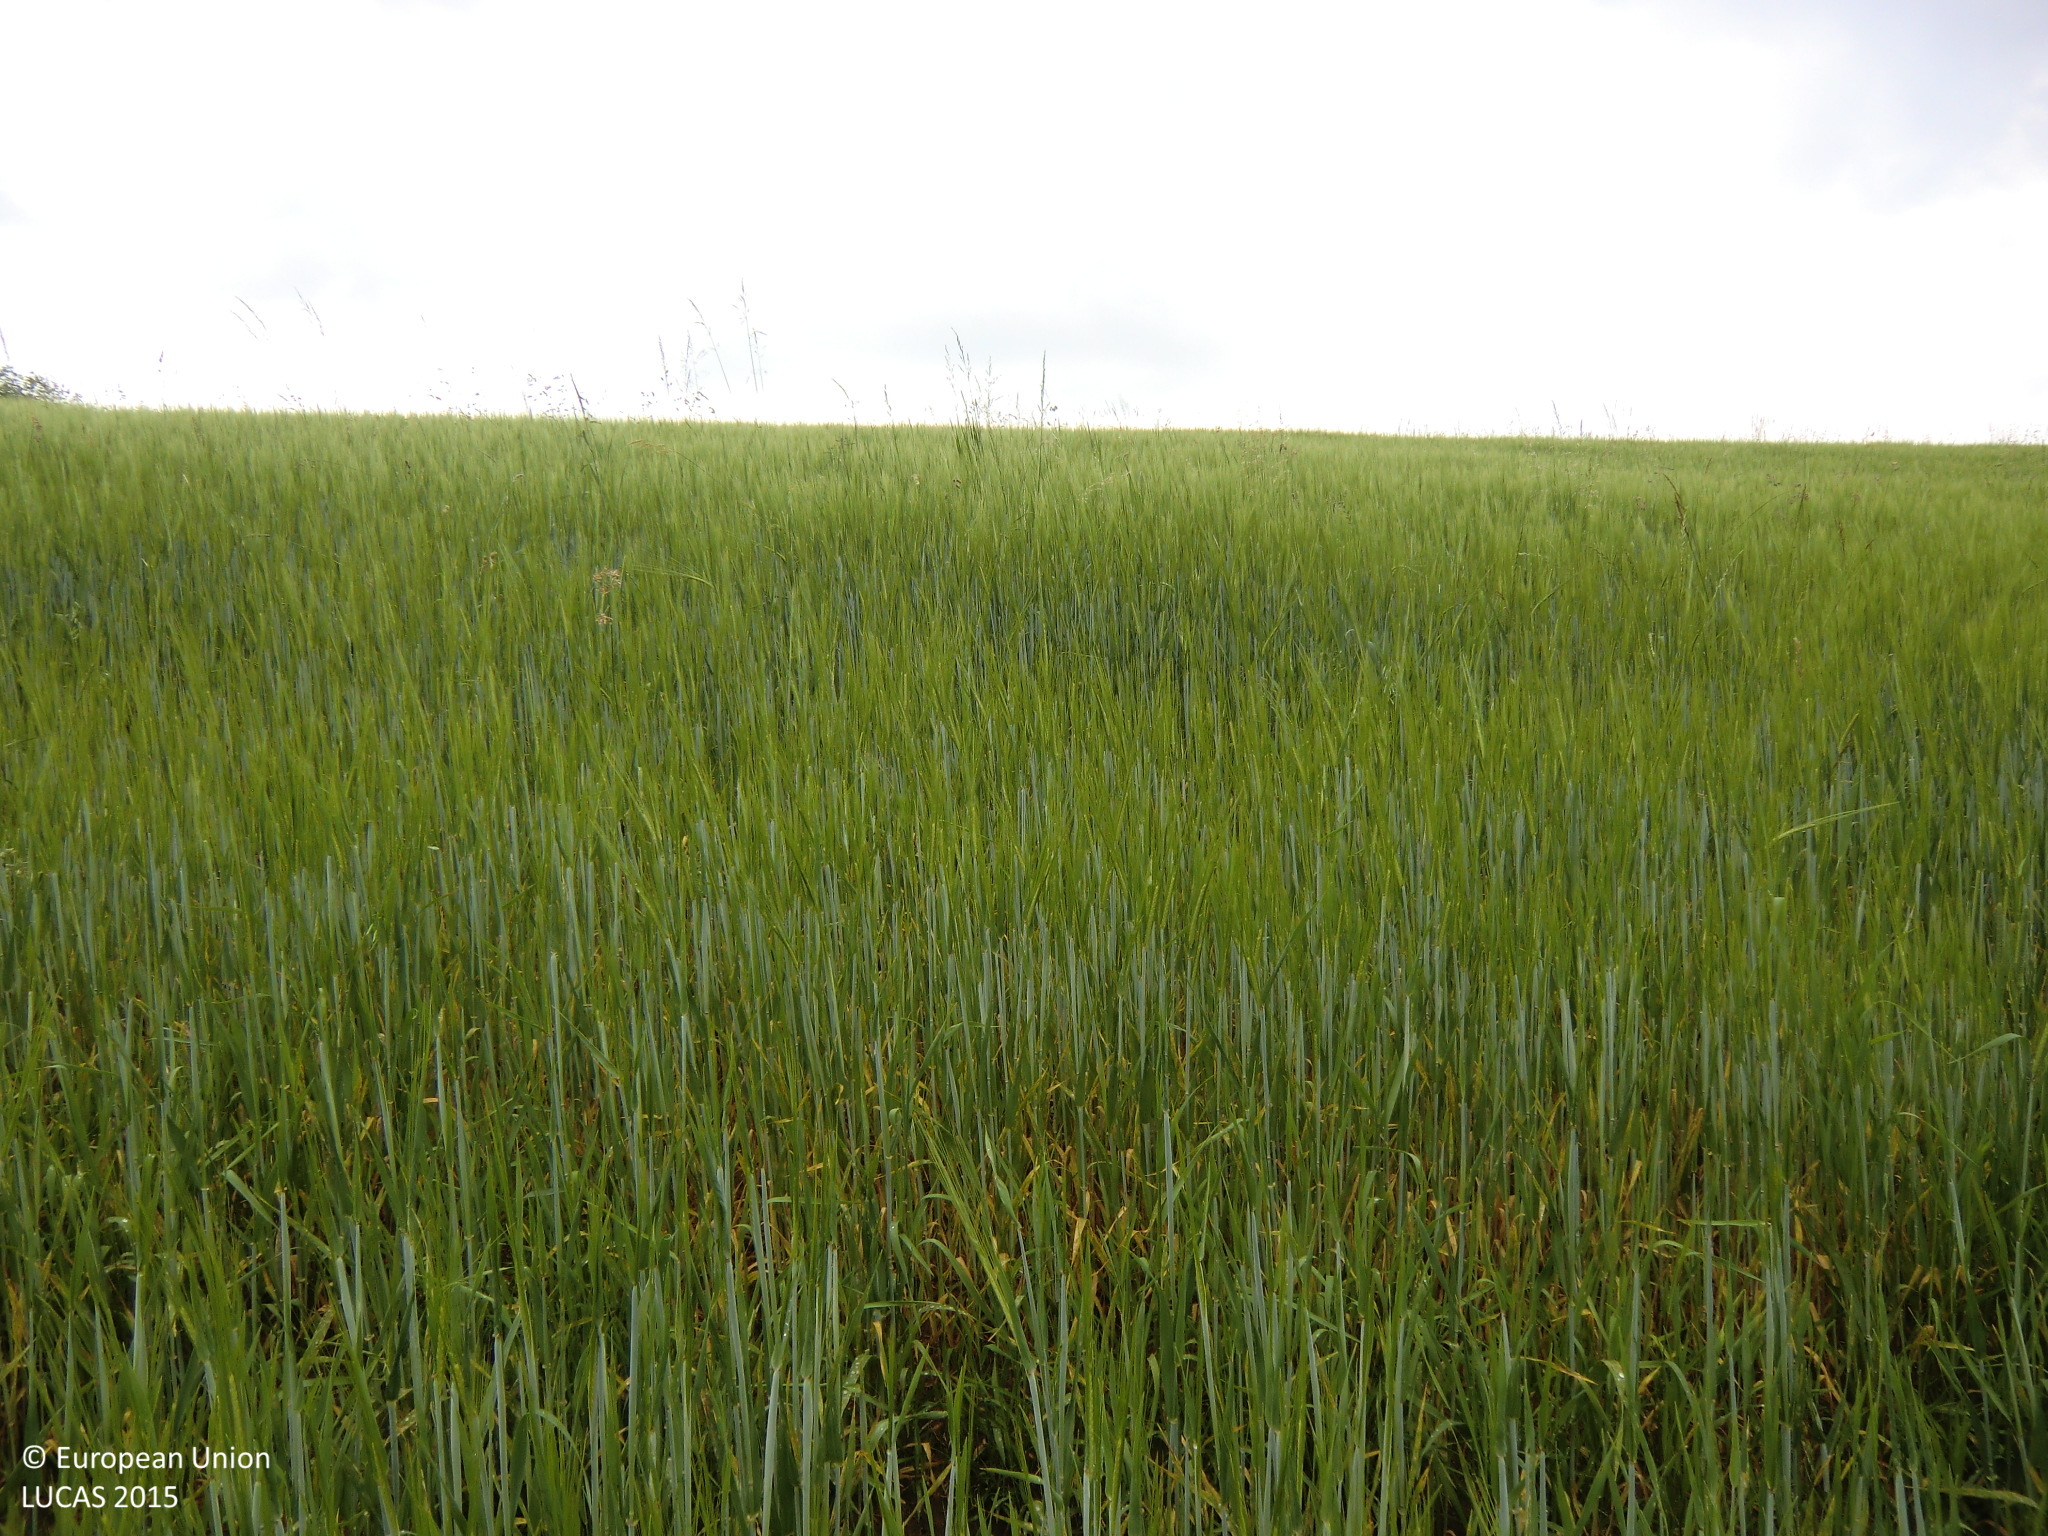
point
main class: Cropland
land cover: Rye
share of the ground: > 75 %
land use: Agriculture (excluding fallow land and kitchen gardens)
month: June
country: AT
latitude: 48.4717
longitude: 14.5591
